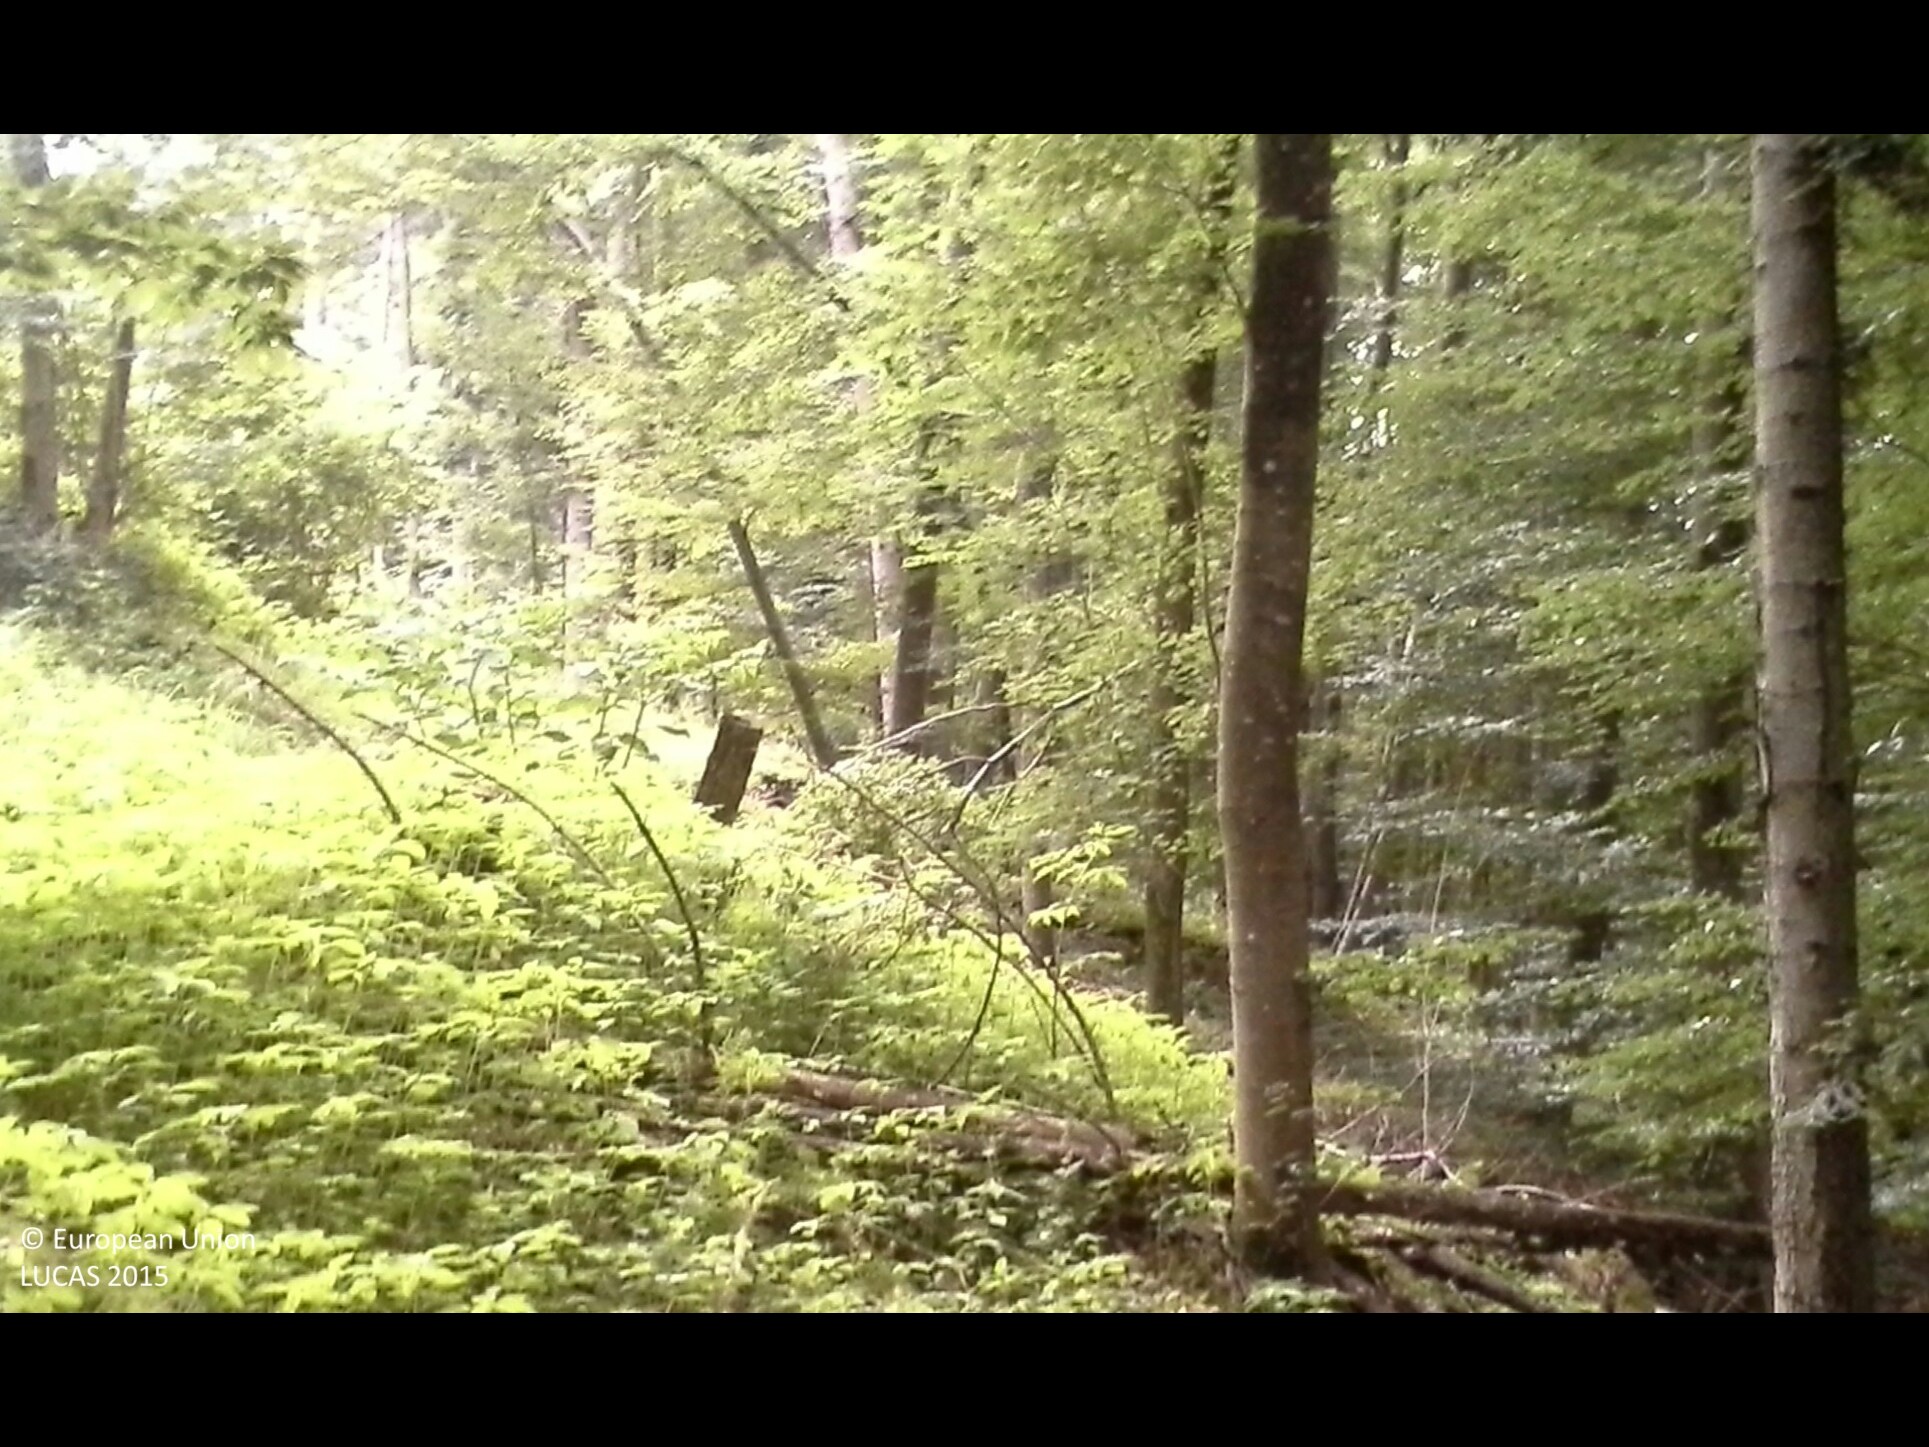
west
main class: Woodland
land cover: Spruce dominated mixed woodland
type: beech forest
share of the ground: > 75 %
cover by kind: broadleaved forest trees 55 %, coniferous forest trees 30 %, herbaceous plants 15 %
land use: Forestry
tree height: > 5 m
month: June
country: AT
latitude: 47.9912
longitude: 14.4086
